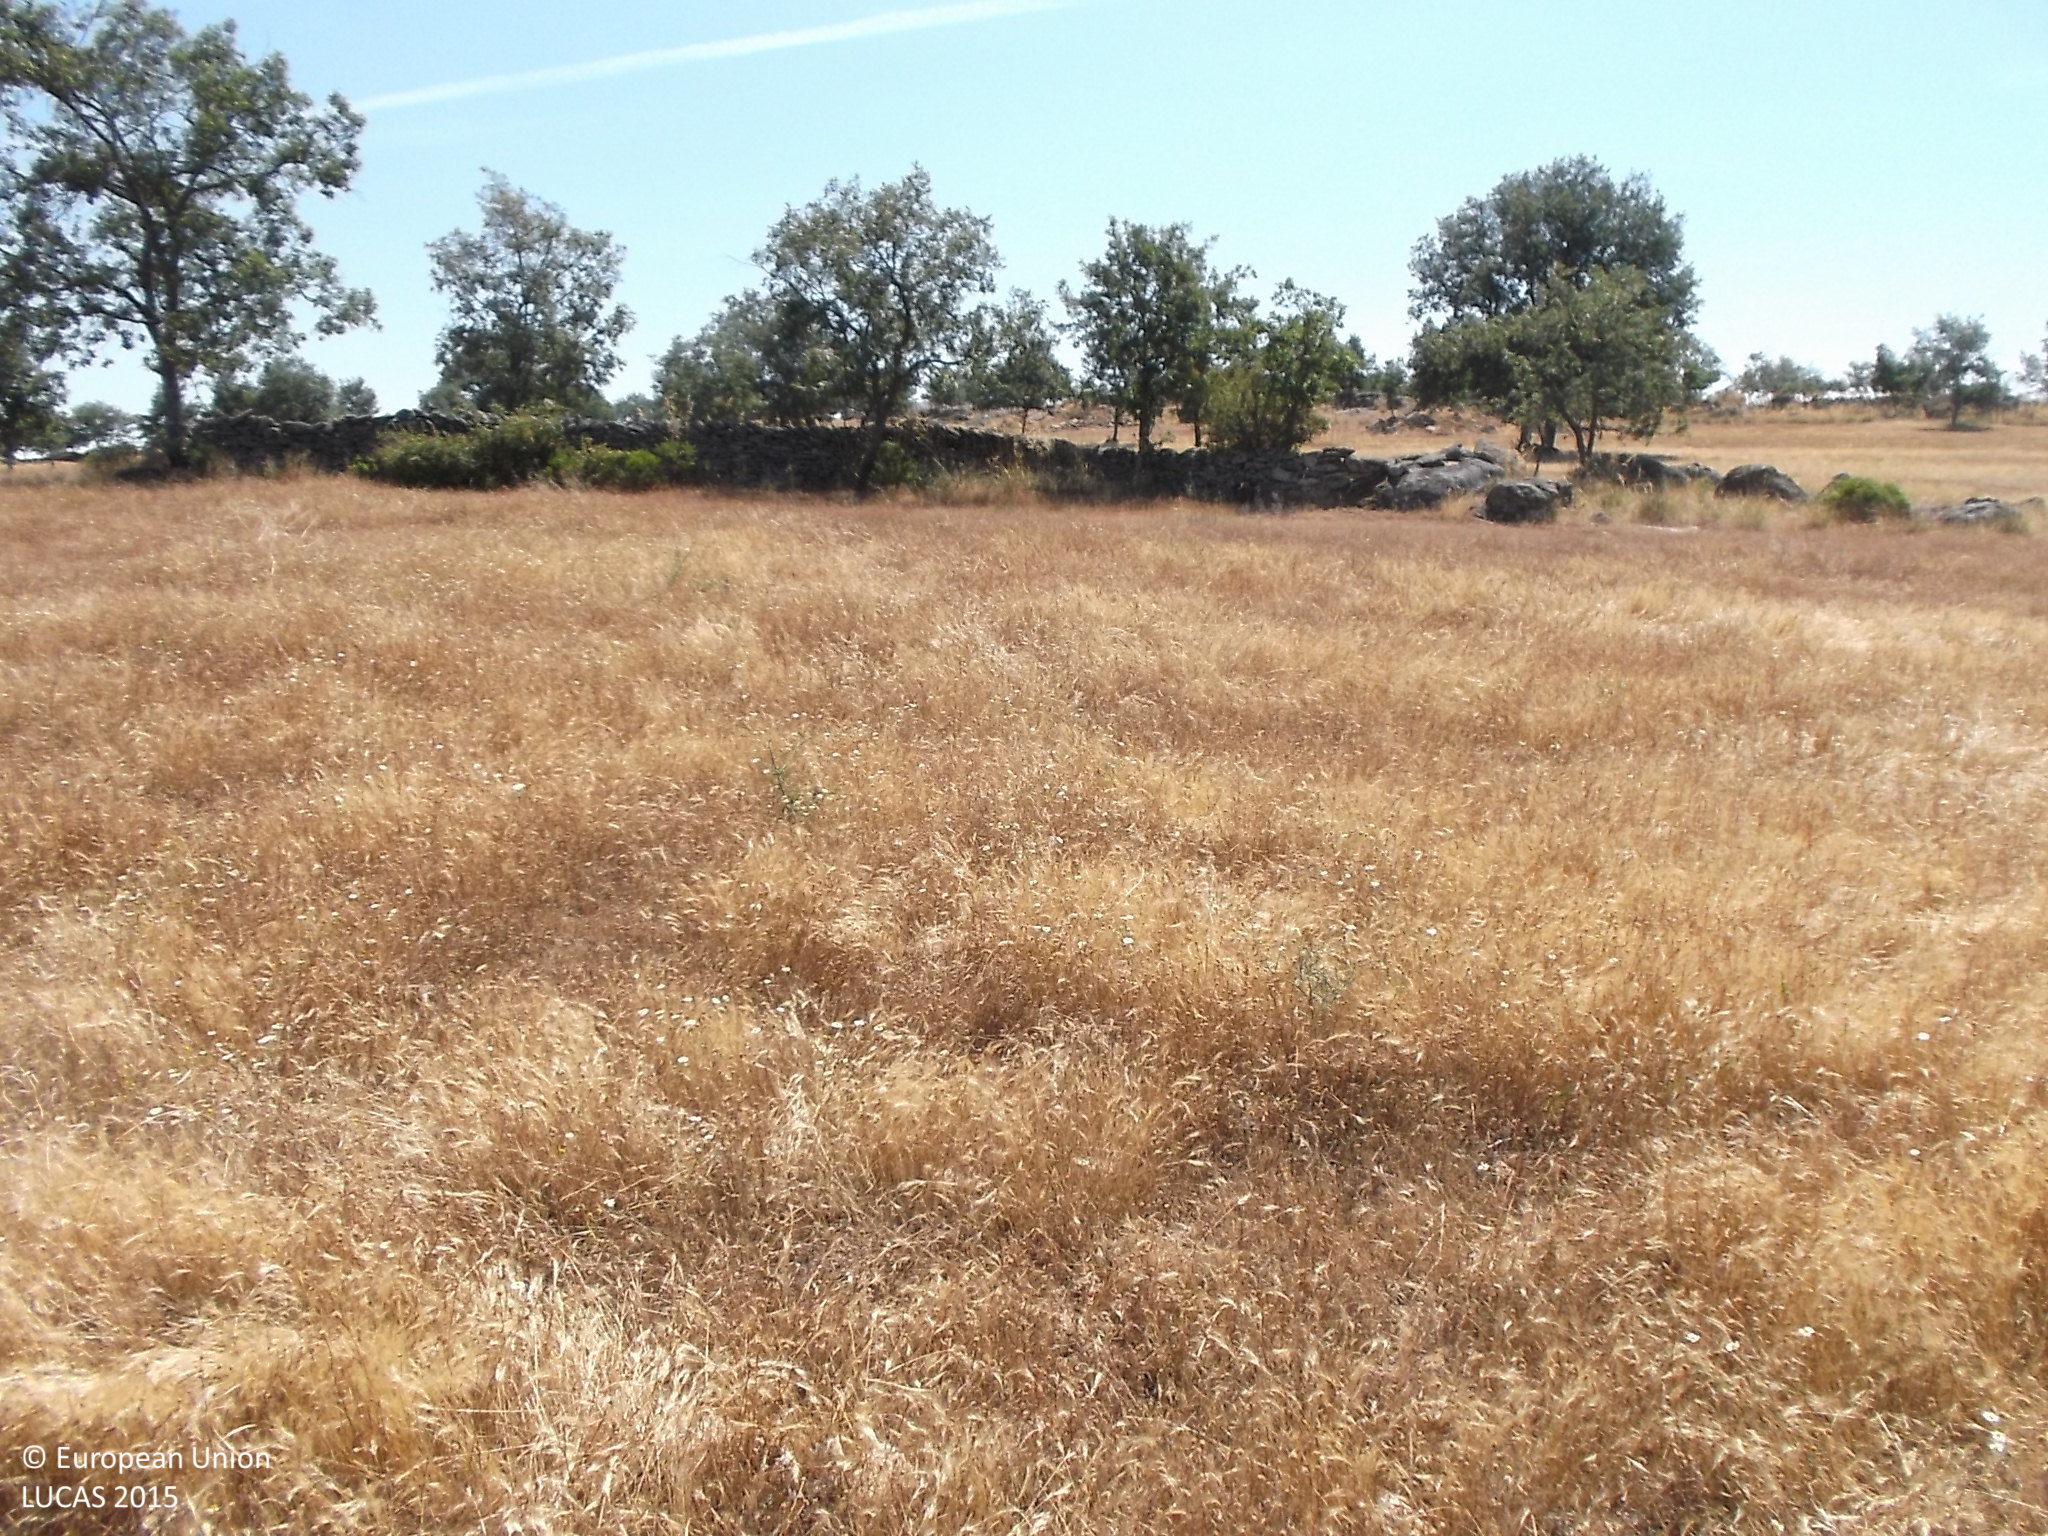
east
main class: Grassland
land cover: Grassland without tree/shrub cover
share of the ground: > 75 %
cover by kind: herbaceous plants 100 %
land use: Agriculture (excluding fallow land and kitchen gardens)
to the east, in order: Grassland without tree/shrub cover; Dry stone walls; Rocks and stones; Grassland without tree/shrub cover; Rocks and stones; Grassland without tree/shrub cover; Fences; Grassland without tree/shrub cover; Rocks and stones; Grassland with sparse tree/shrub cover
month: July
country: ES
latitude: 41.1851
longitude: -6.4661
